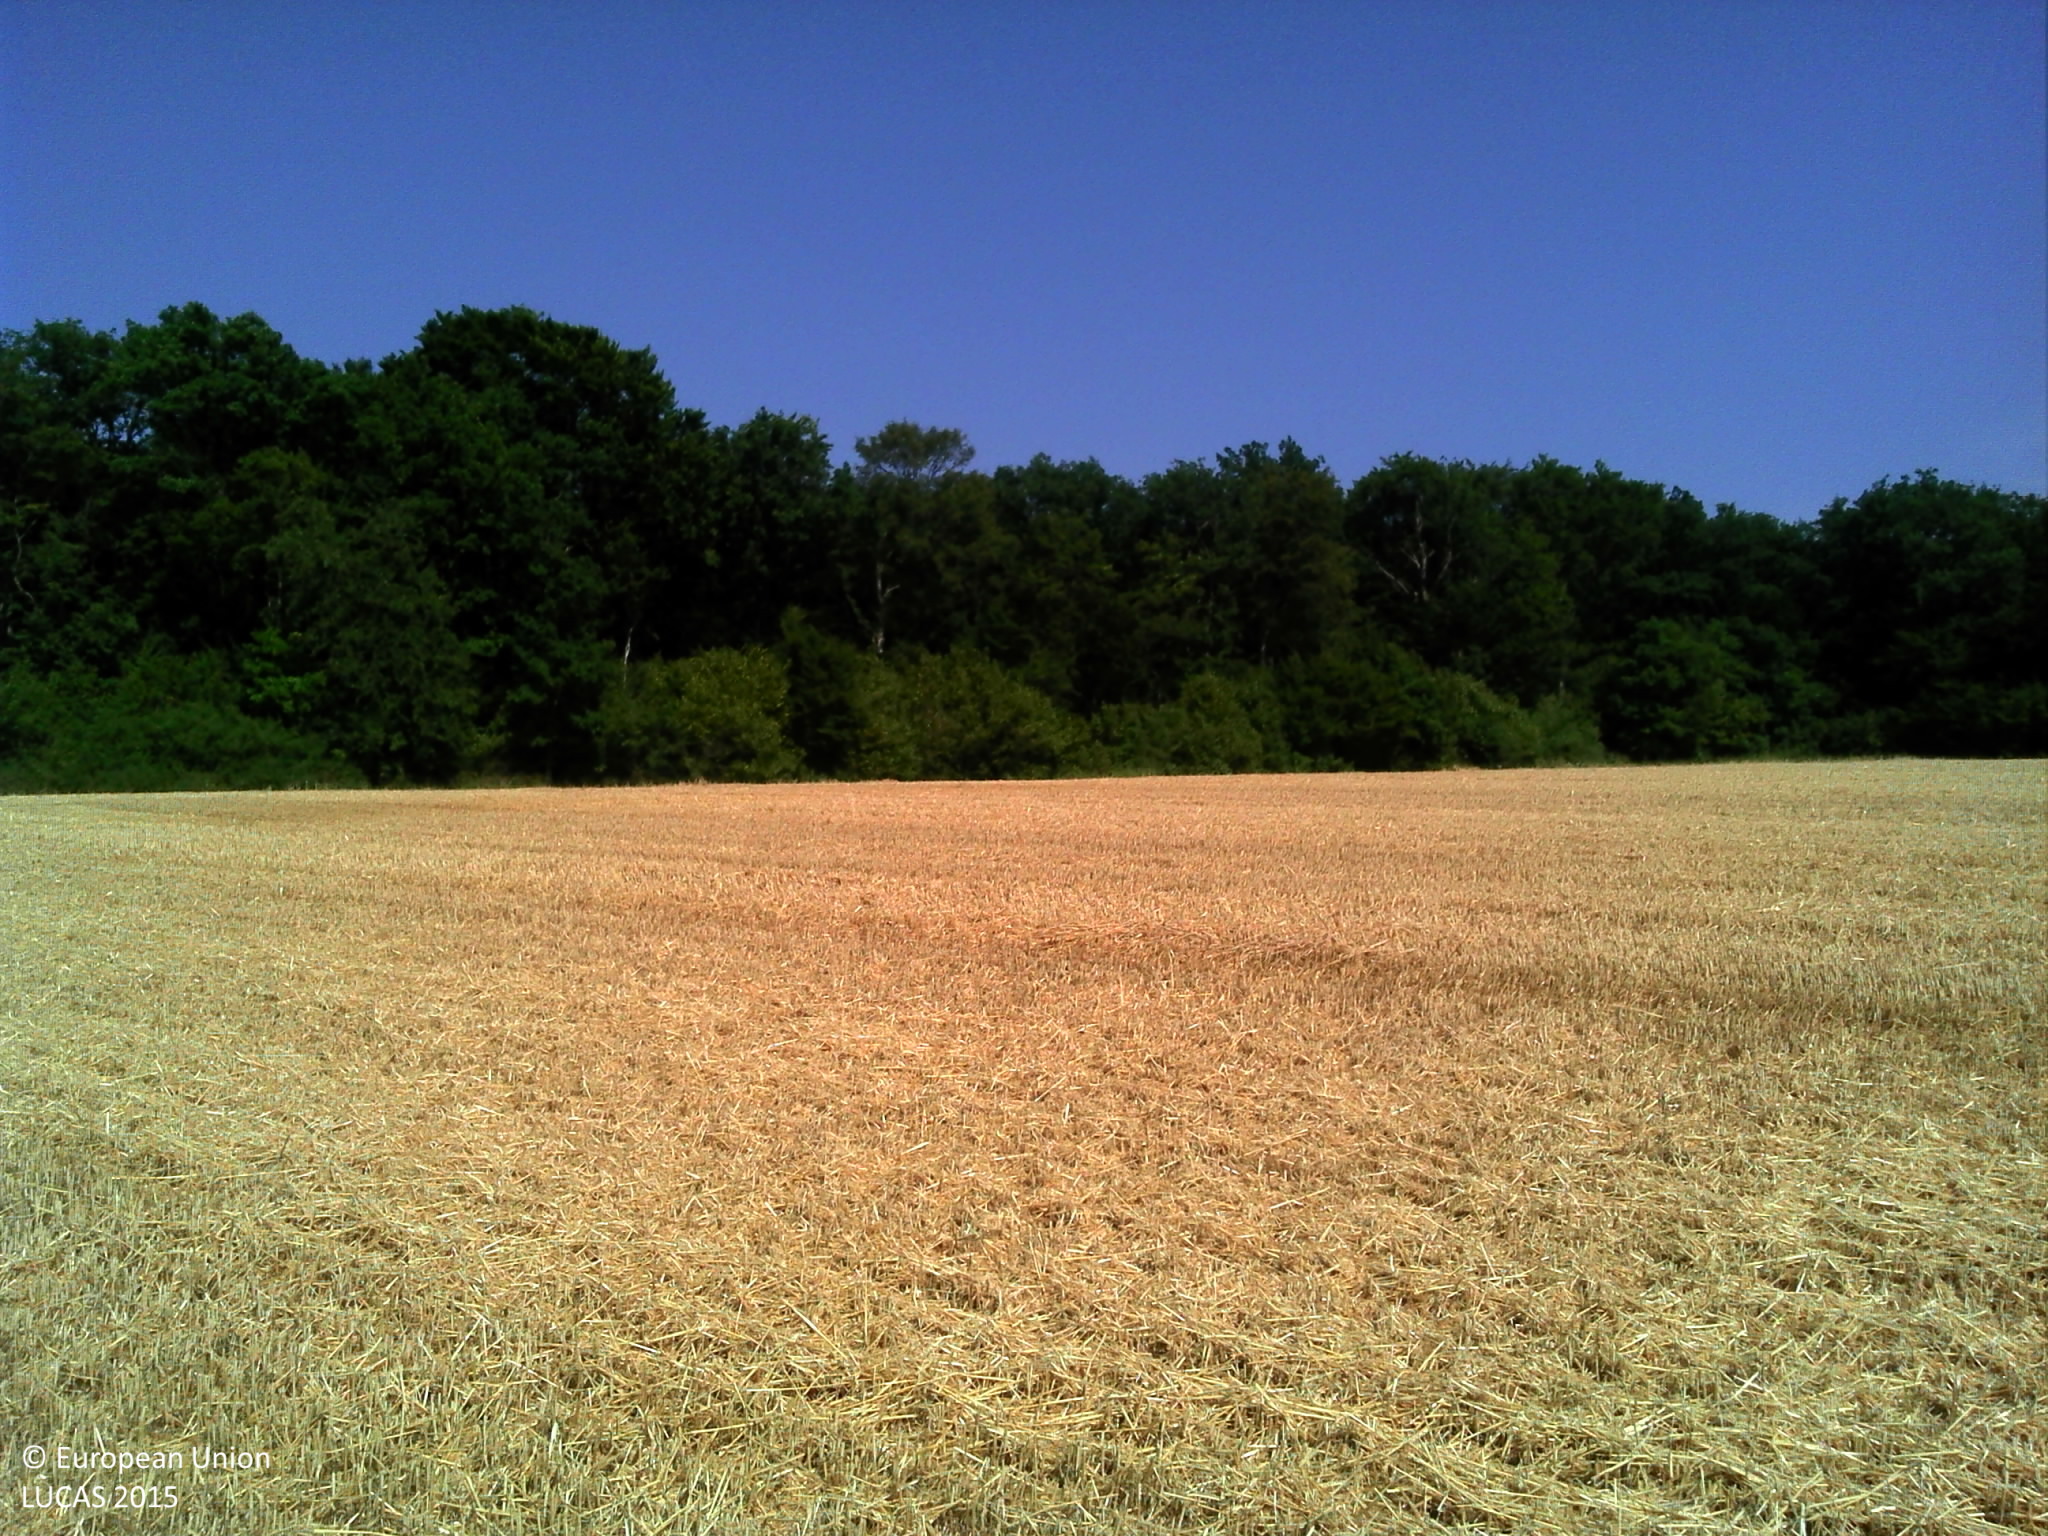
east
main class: Cropland
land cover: Common wheat
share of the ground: 10 - 25 %
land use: Agriculture (excluding fallow land and kitchen gardens)
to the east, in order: Common wheat; Broadleaved woodland; Tracks; Broadleaved woodland
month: July
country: FR
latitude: 48.0651
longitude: 4.8053
